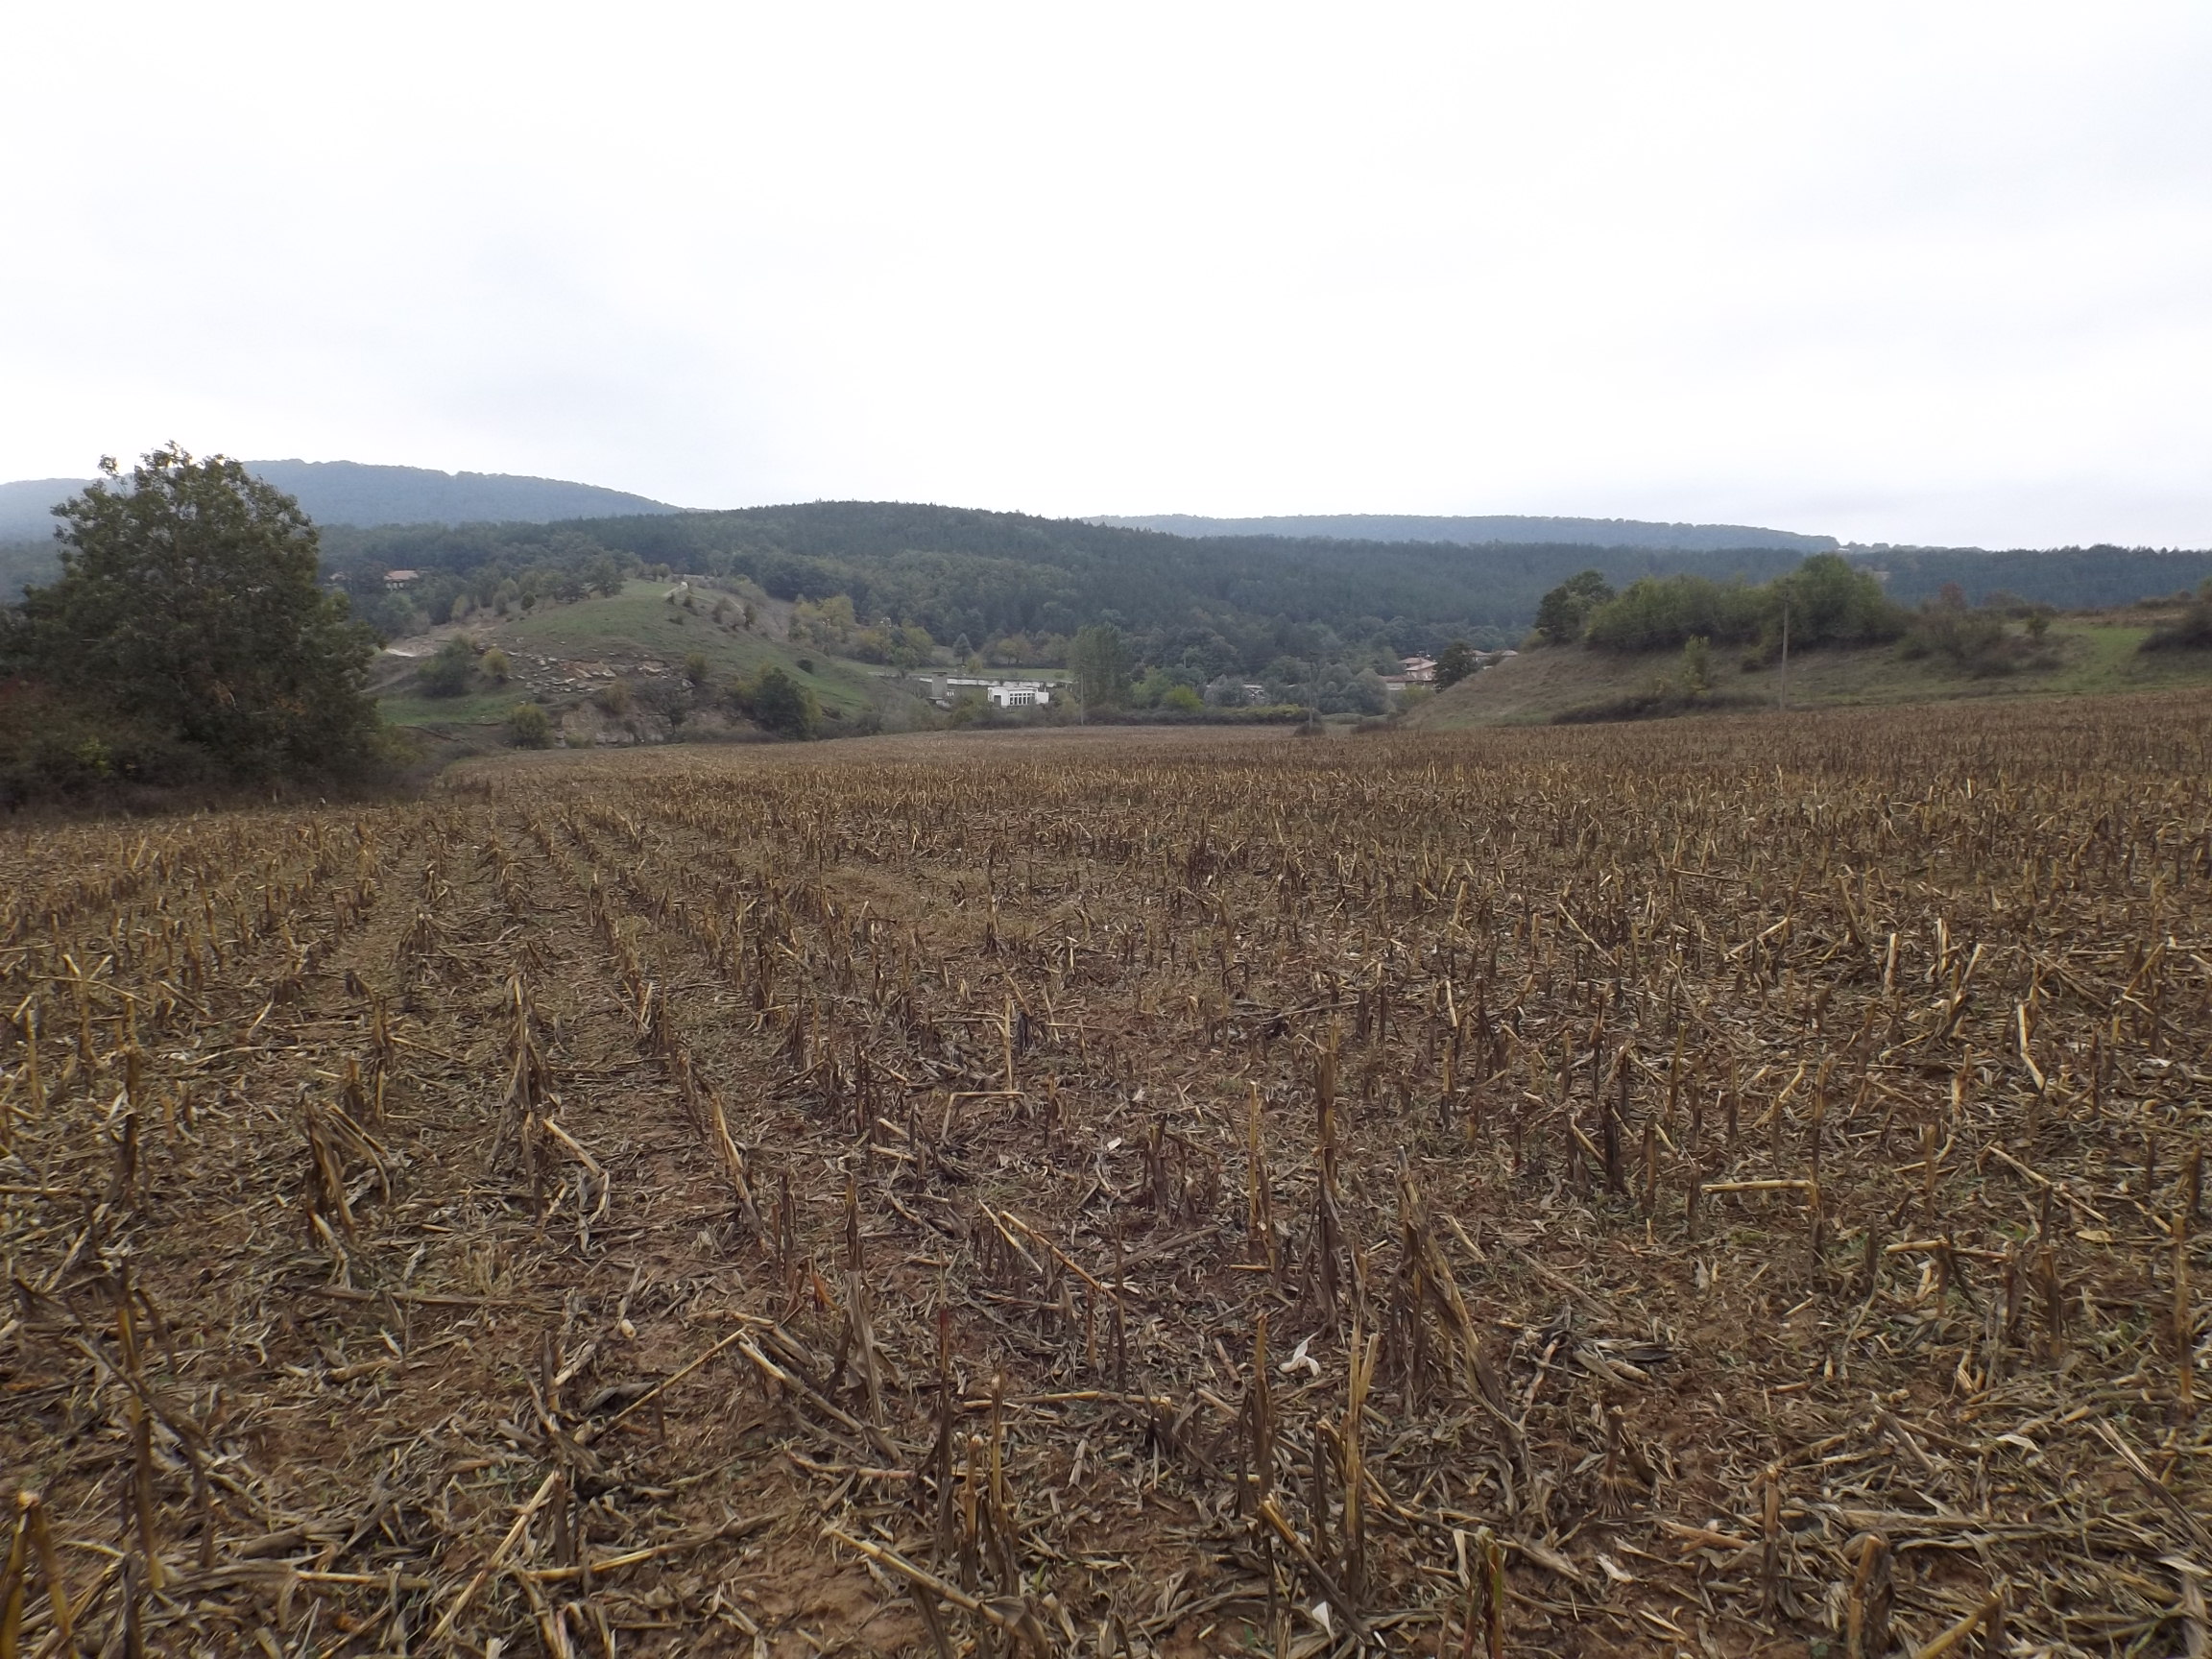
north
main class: Cropland
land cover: Maize
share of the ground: 10 - 25 %
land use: Agriculture (excluding fallow land and kitchen gardens)
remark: Harvested field
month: October
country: BG
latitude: 42.9969
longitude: 27.1780
